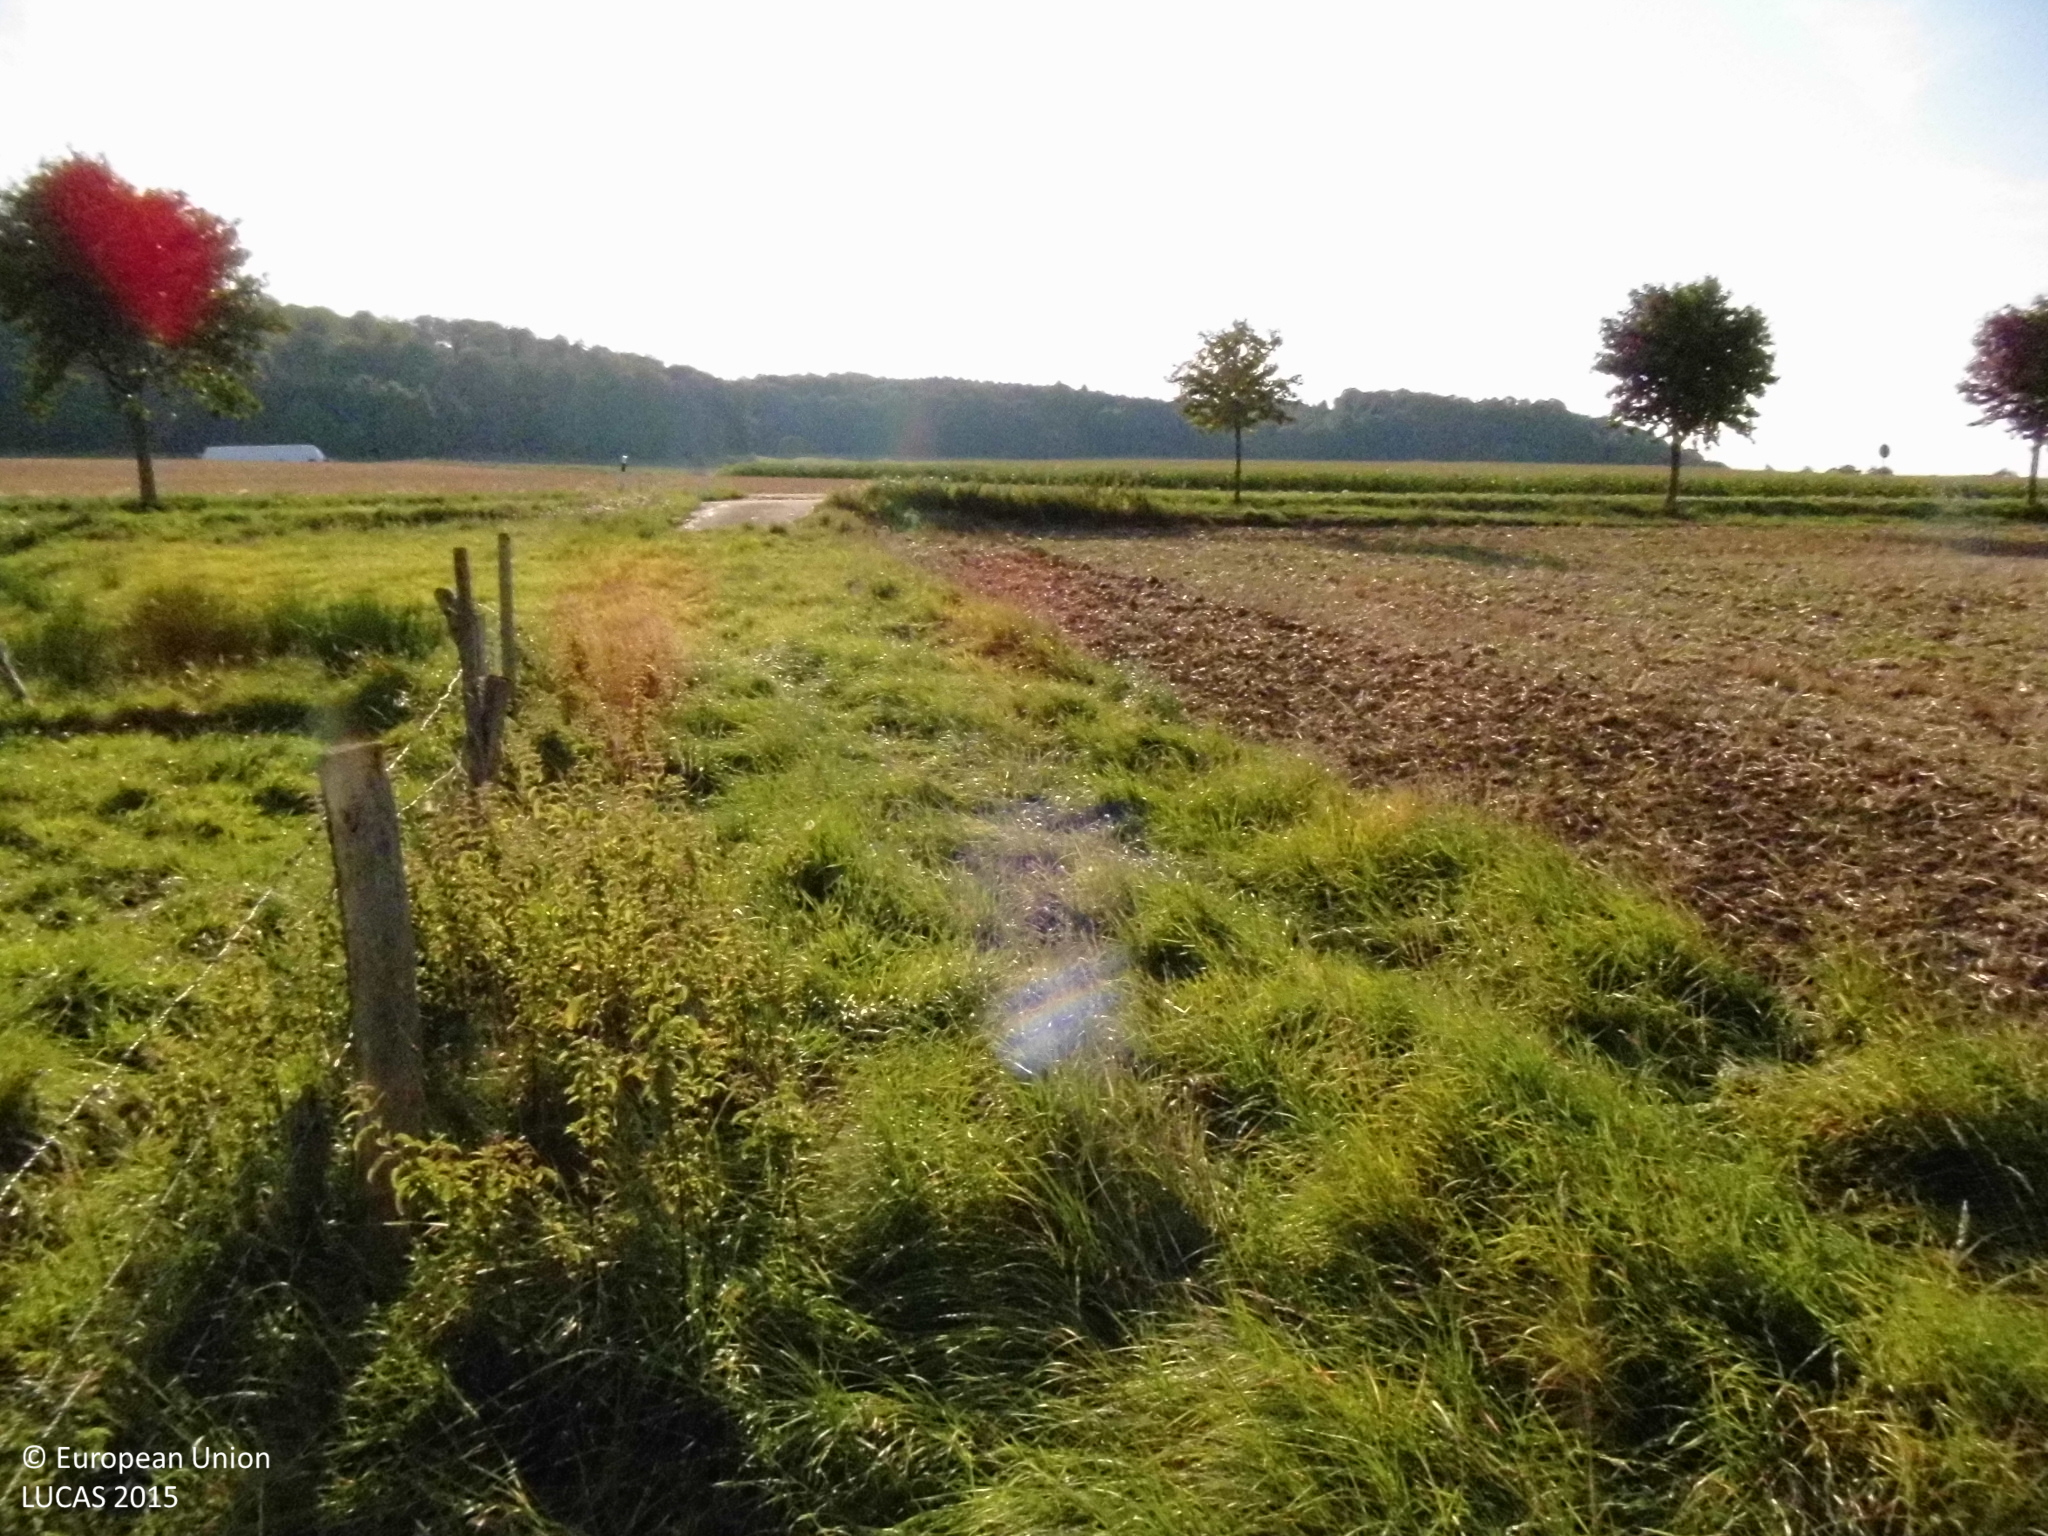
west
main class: Grassland
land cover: Grassland without tree/shrub cover
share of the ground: > 75 %
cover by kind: herbaceous plants 100 %
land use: Agriculture (excluding fallow land and kitchen gardens)
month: August
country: DE
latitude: 50.4921
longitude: 8.0974
